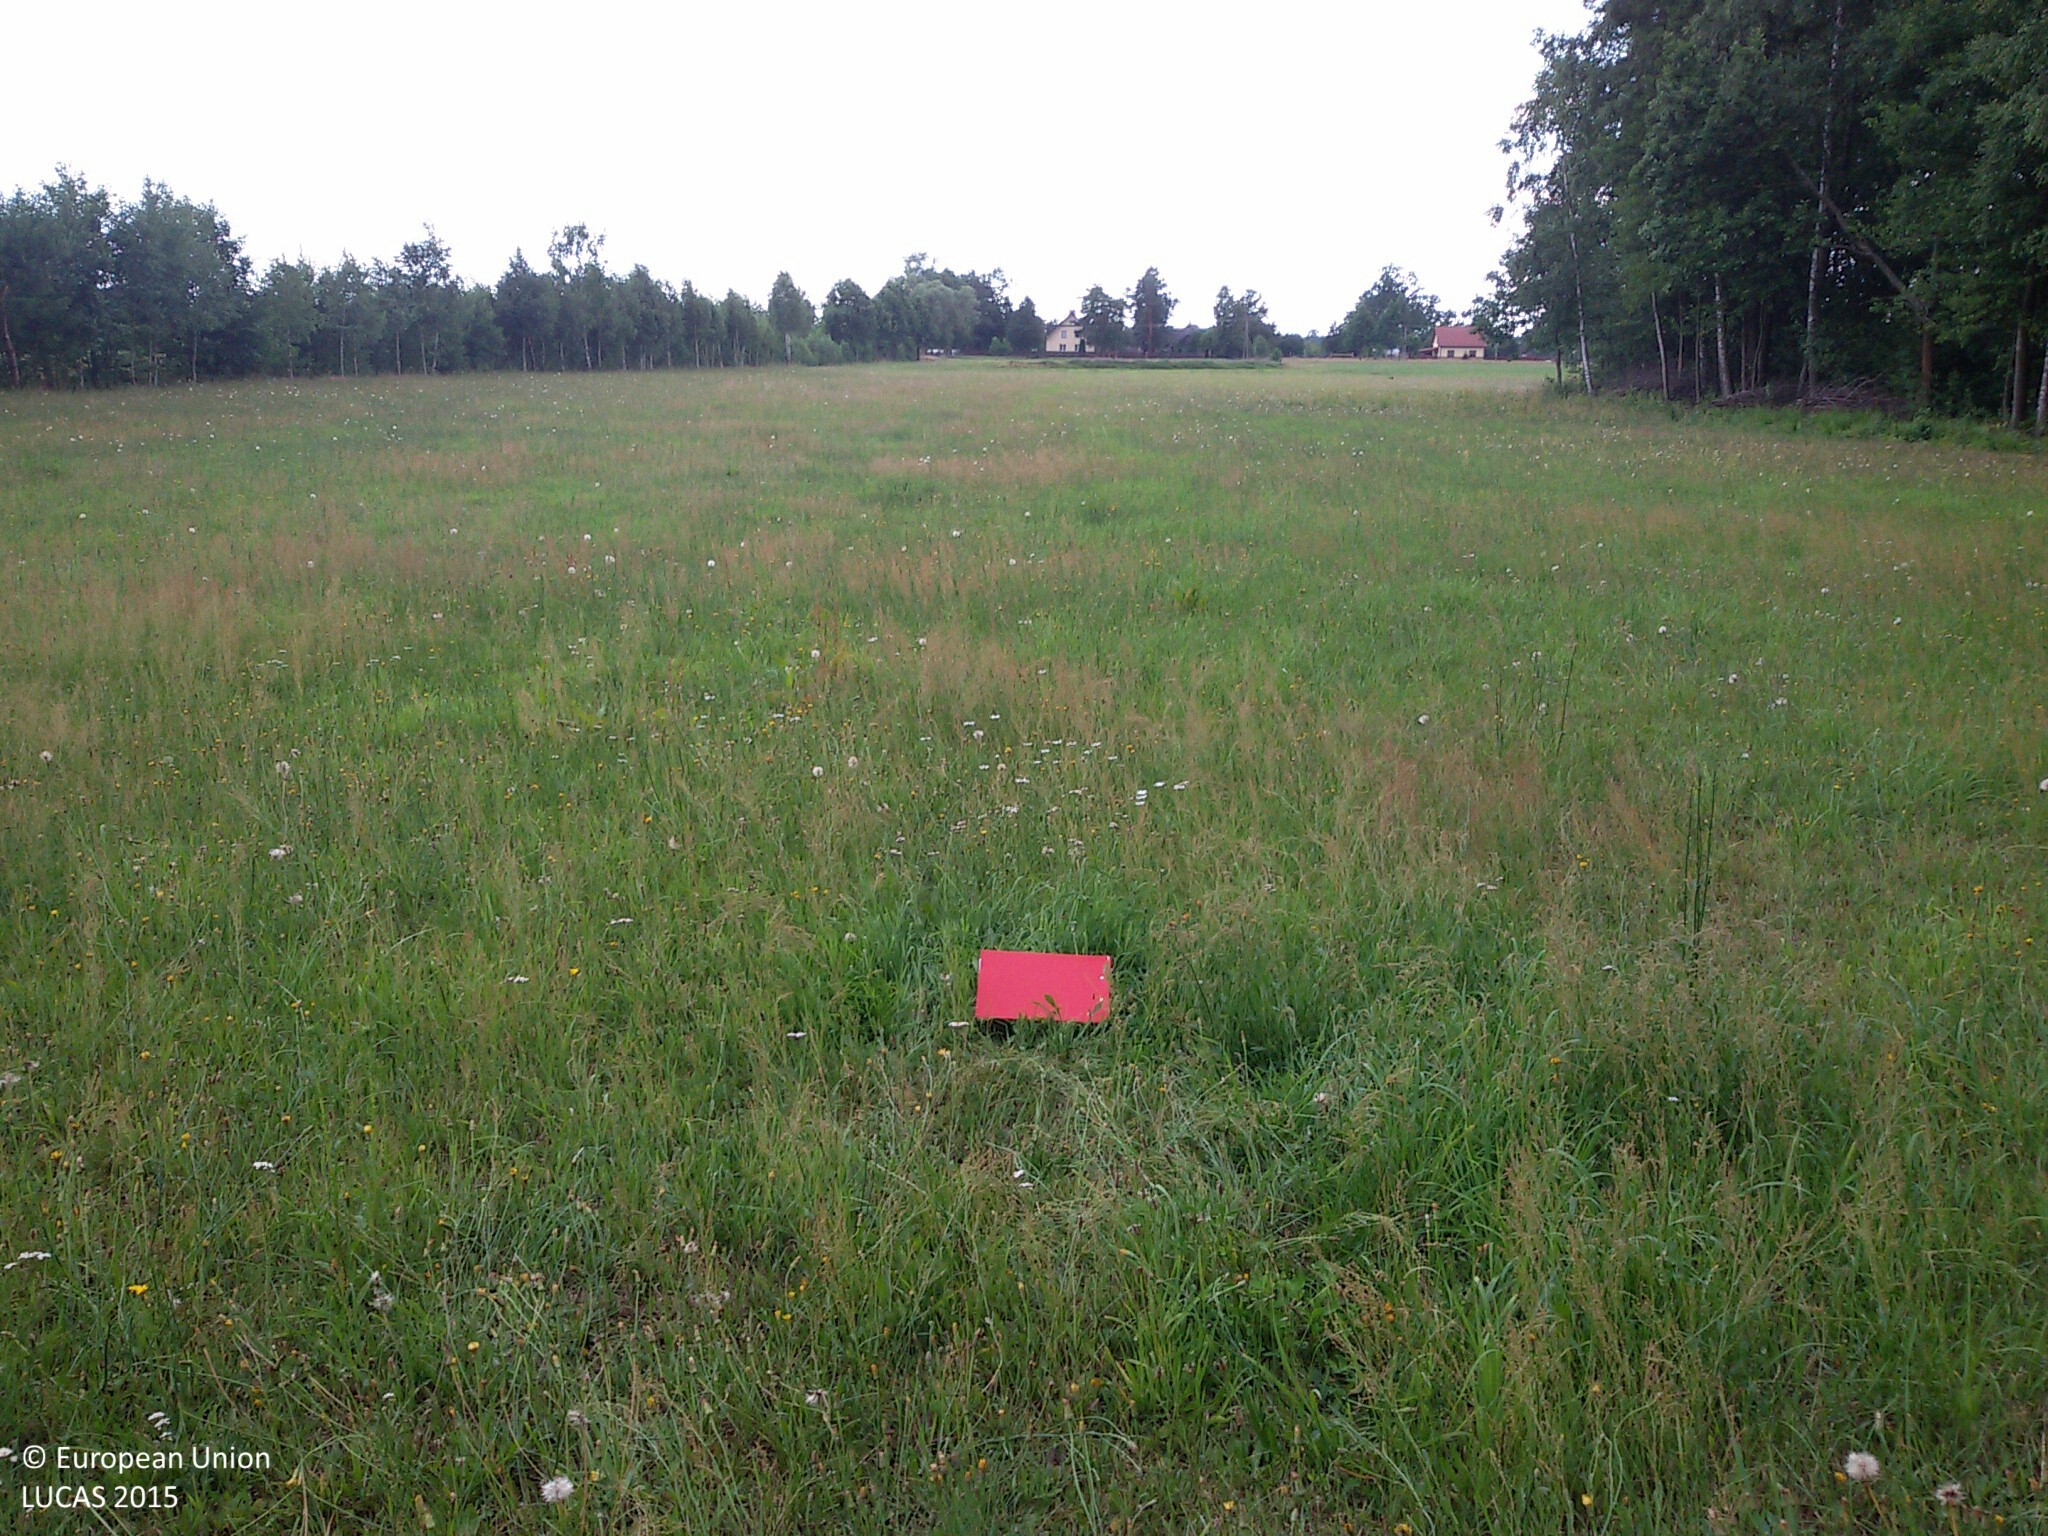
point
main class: Grassland
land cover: Grassland without tree/shrub cover
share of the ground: > 75 %
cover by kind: herbaceous plants 100 %
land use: Agriculture (excluding fallow land and kitchen gardens)
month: July
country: PL
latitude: 53.2912
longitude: 21.4662
